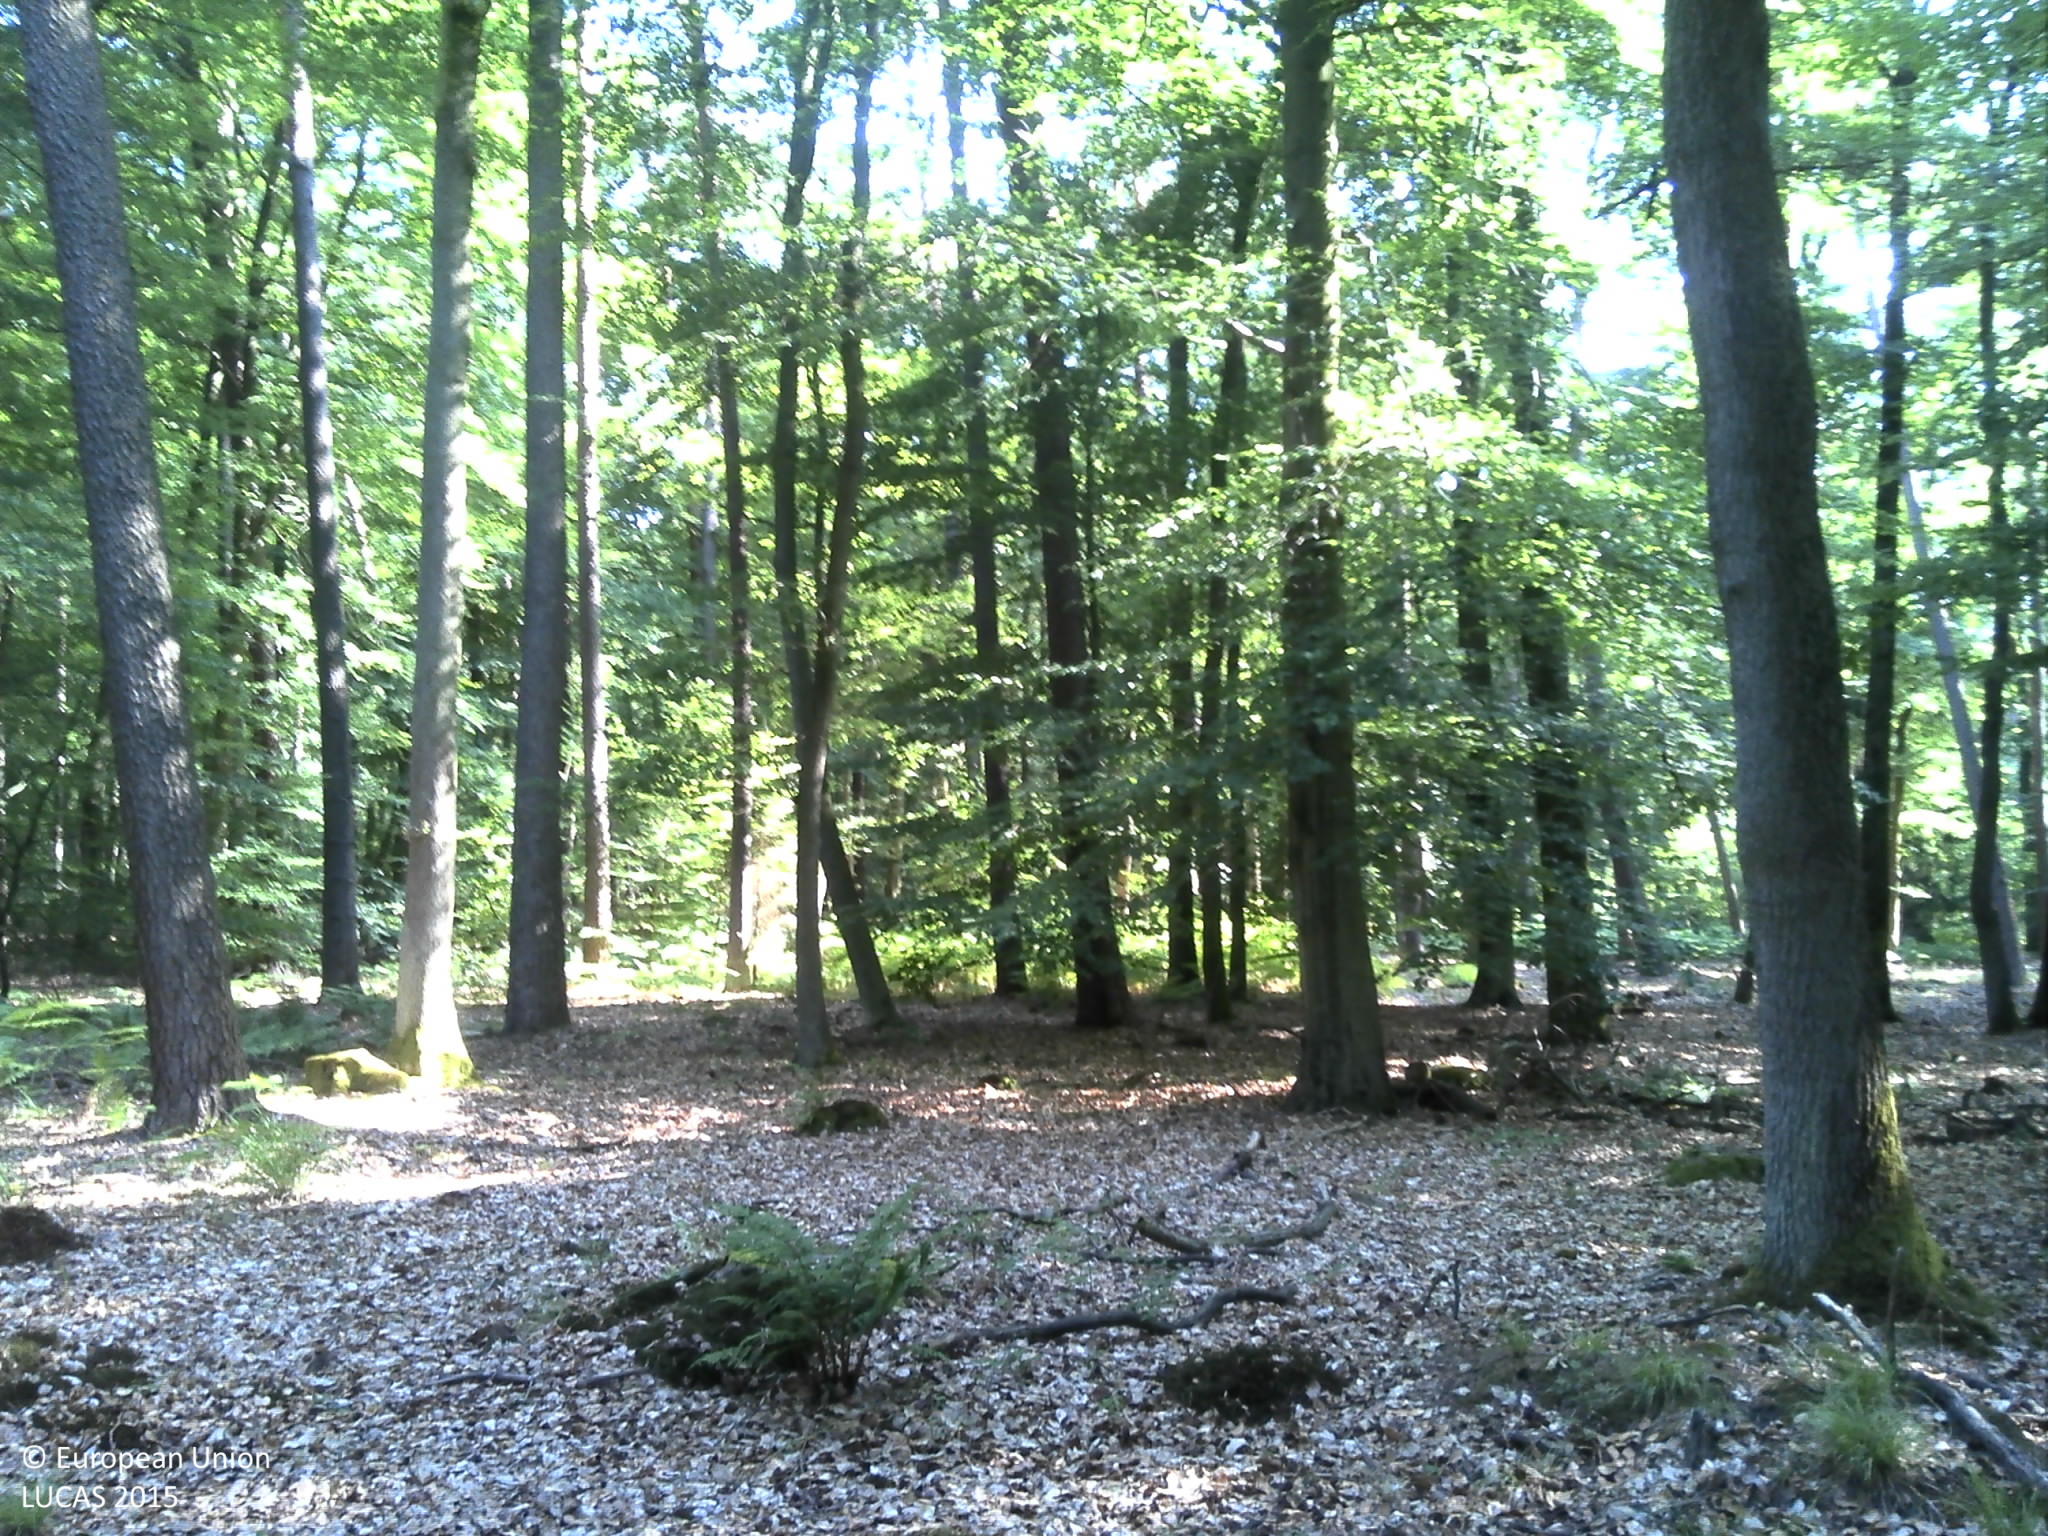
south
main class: Woodland
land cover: Pine dominated mixed woodland
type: acidophilous oak and oak-birch forest
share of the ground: > 75 %
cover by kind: coniferous forest trees 50 %, broadleaved forest trees 50 %
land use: Forestry
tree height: > 5 m
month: July
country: FR
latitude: 49.1480
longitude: 6.7510
